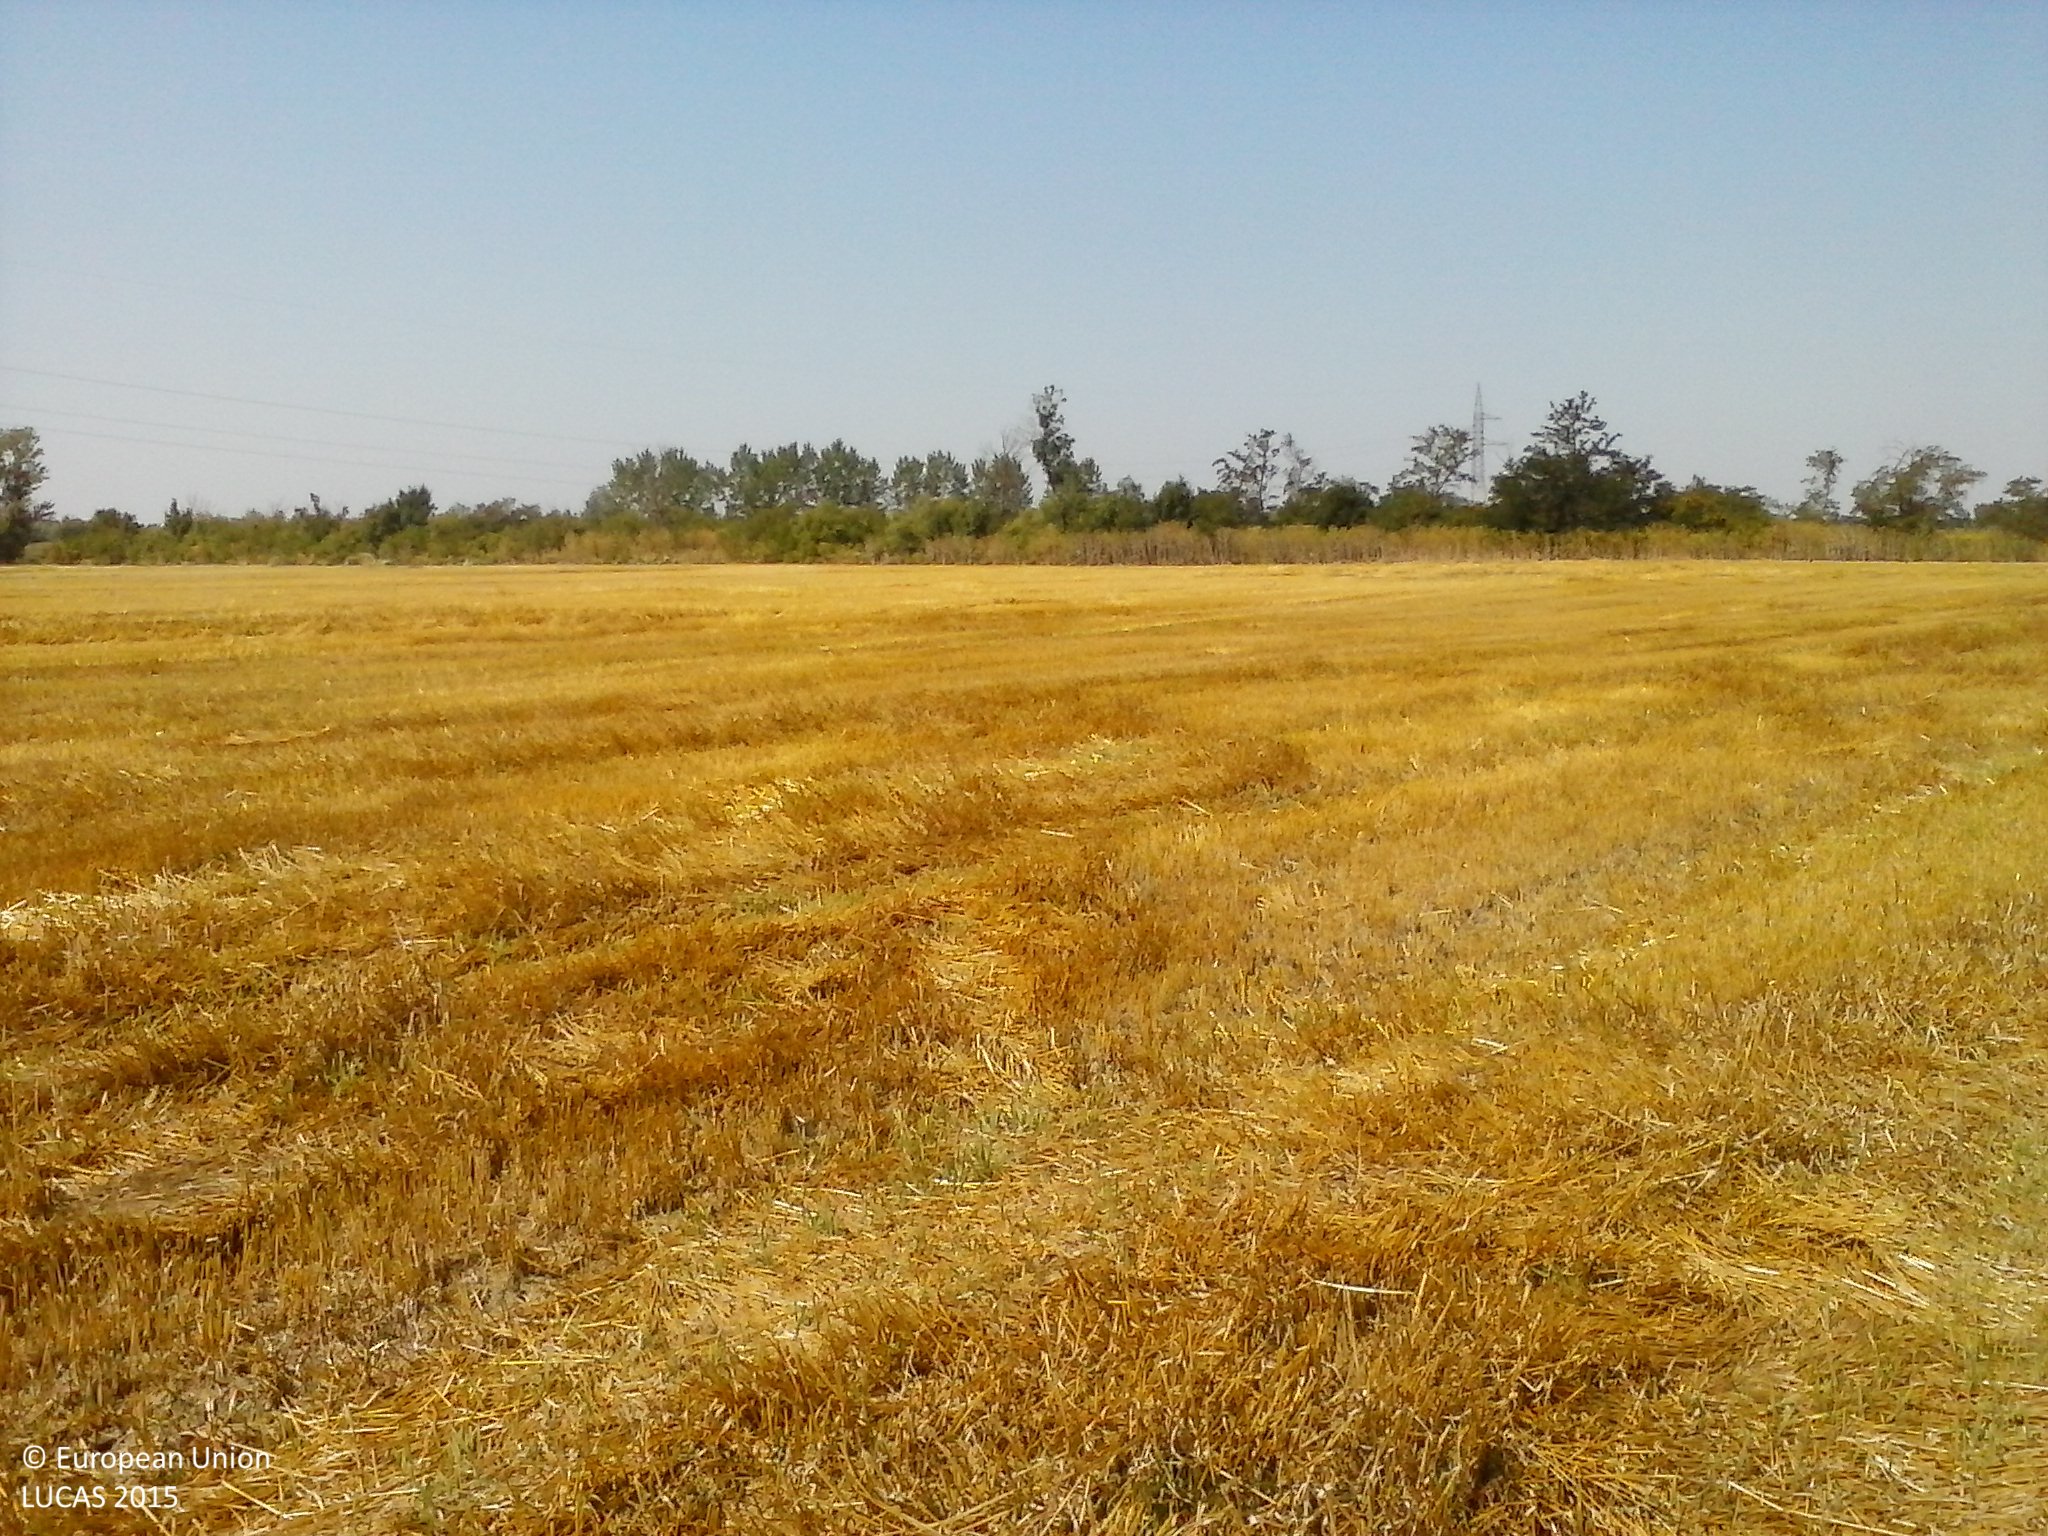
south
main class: Cropland
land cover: Common wheat
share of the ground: > 75 %
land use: Agriculture (excluding fallow land and kitchen gardens)
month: June
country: HU
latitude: 46.6607
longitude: 20.3897
